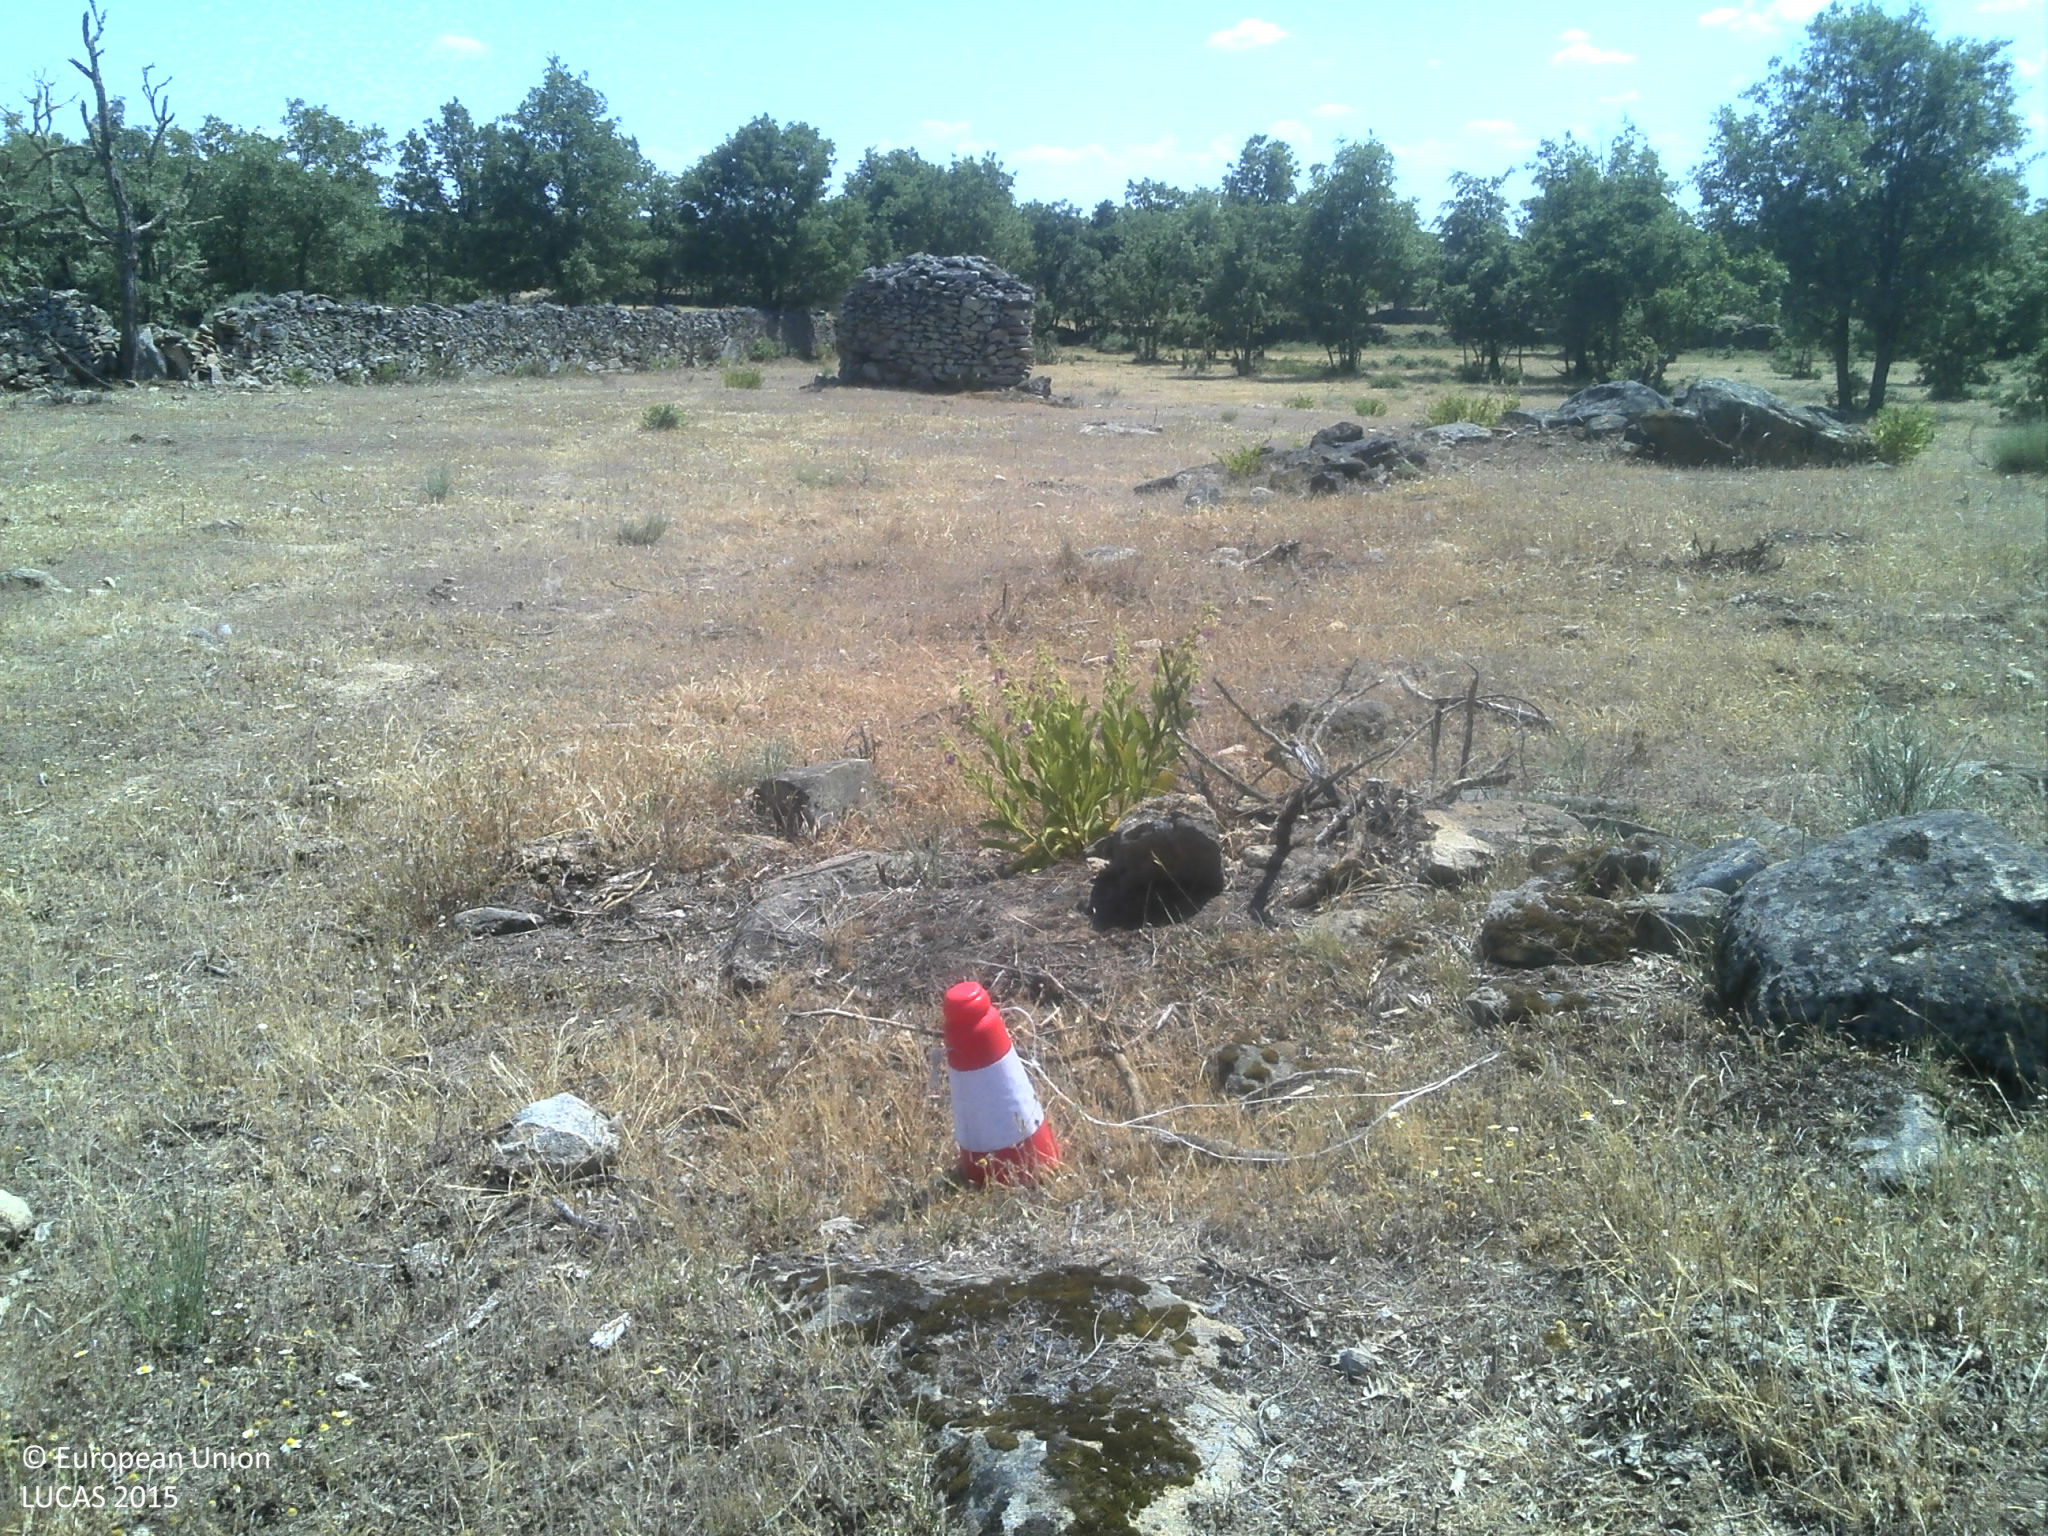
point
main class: Grassland
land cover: Grassland with sparse tree/shrub cover
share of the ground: 25 - 50 %
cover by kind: unconsolidated bare surface 40 %, herbaceous plants 35 %, broadleaved forest trees 5 %, shrubs 5 %
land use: Agriculture (excluding fallow land and kitchen gardens)
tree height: > 5 m
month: June
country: PT
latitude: 40.5230
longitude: -6.8935
